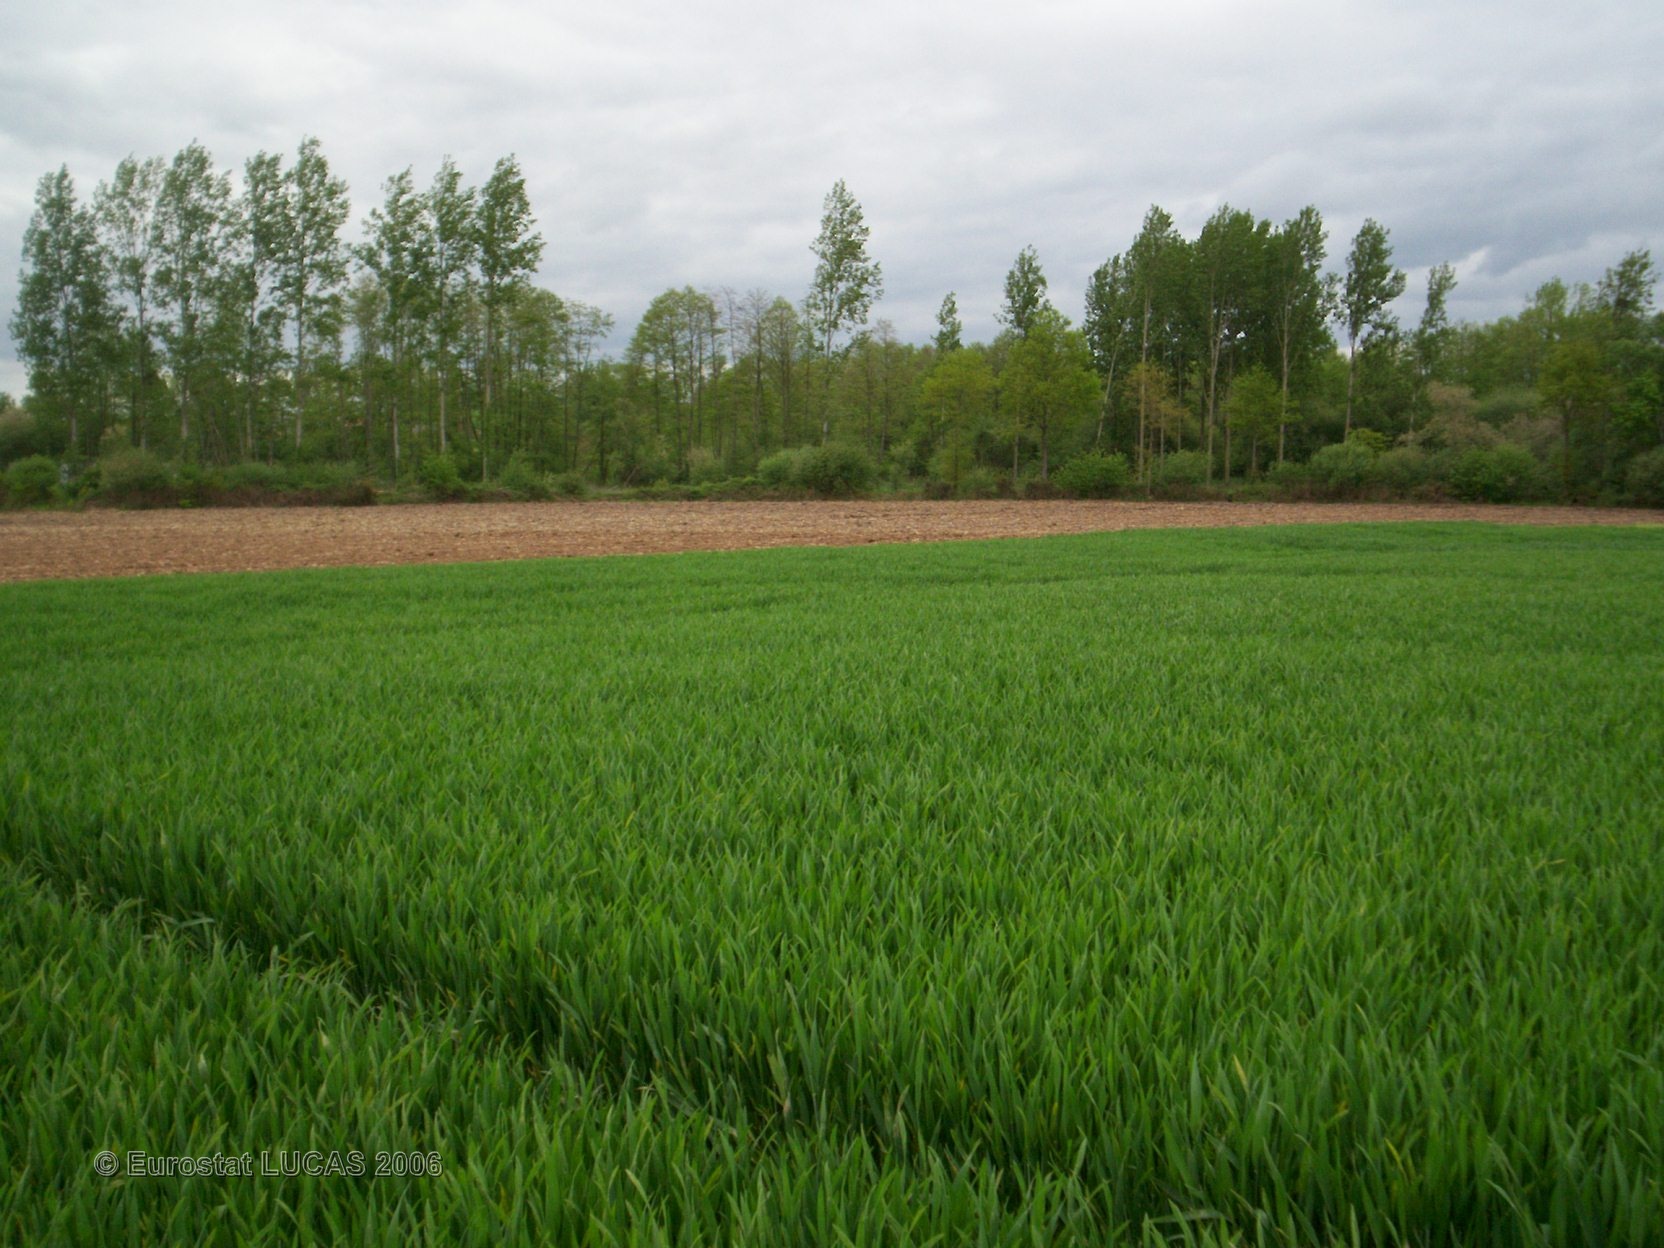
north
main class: Cropland
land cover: Common wheat
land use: Agriculture (excluding fallow land and kitchen gardens)
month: May
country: FR
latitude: 48.2878
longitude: -1.1882
